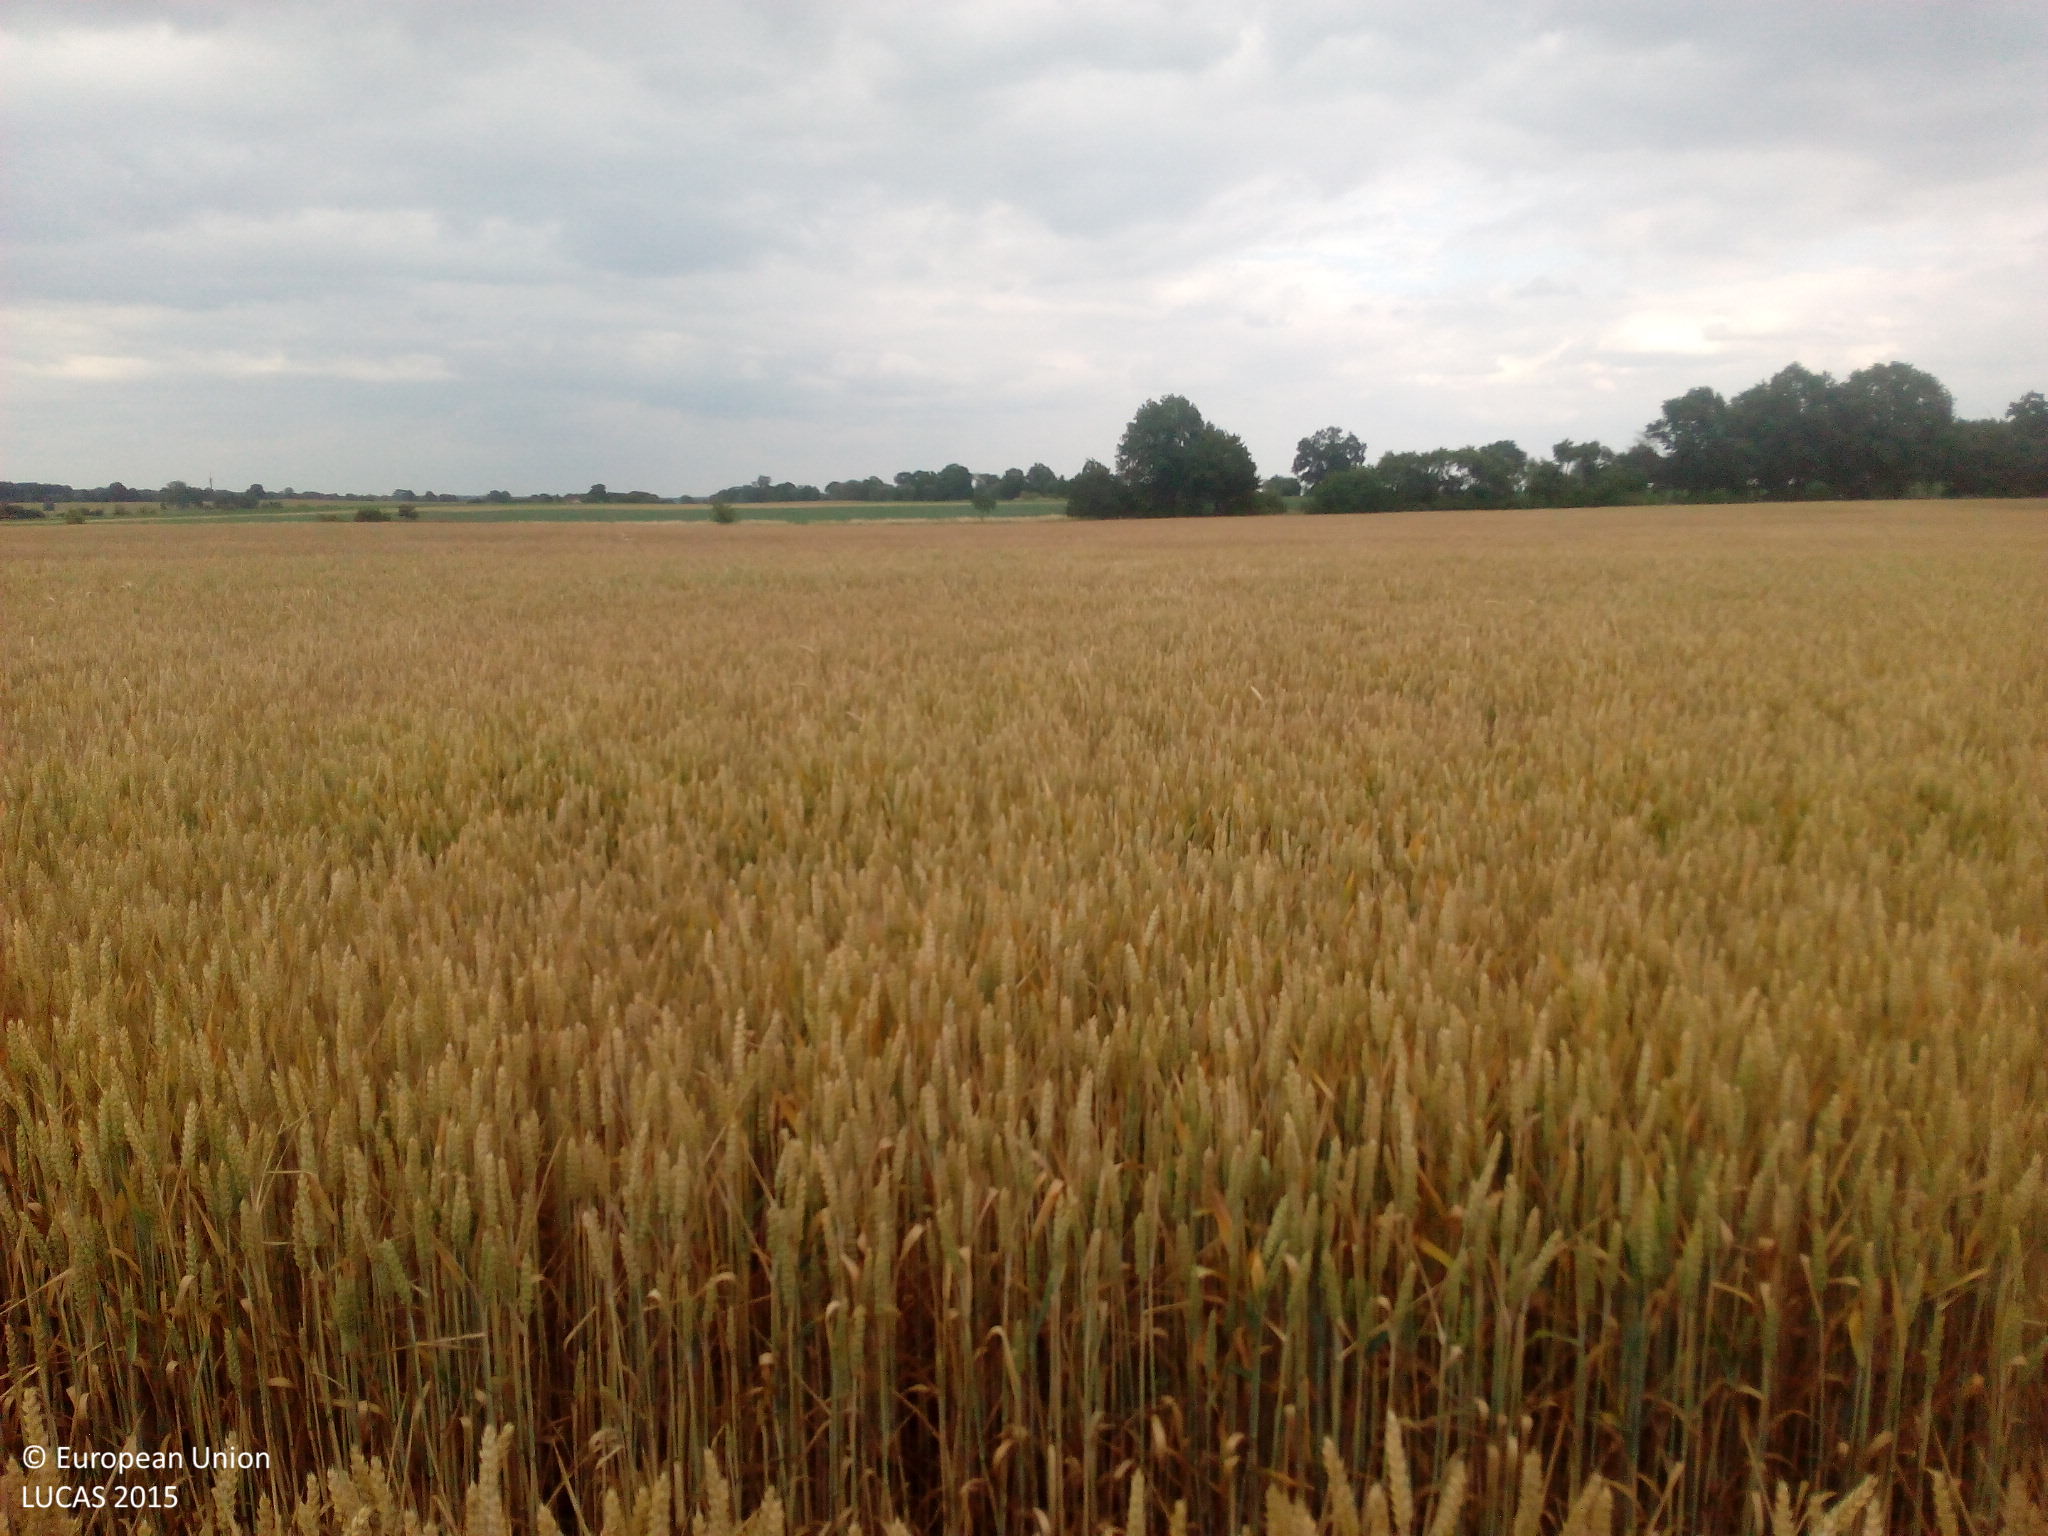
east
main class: Cropland
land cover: Common wheat
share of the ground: > 75 %
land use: Agriculture (excluding fallow land and kitchen gardens)
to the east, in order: Common wheat; Grass margins; Paved roads, cycling and walking lanes; Lines of trees; Shruby margins; Maize
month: July
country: DE
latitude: 52.9120
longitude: 12.3341
